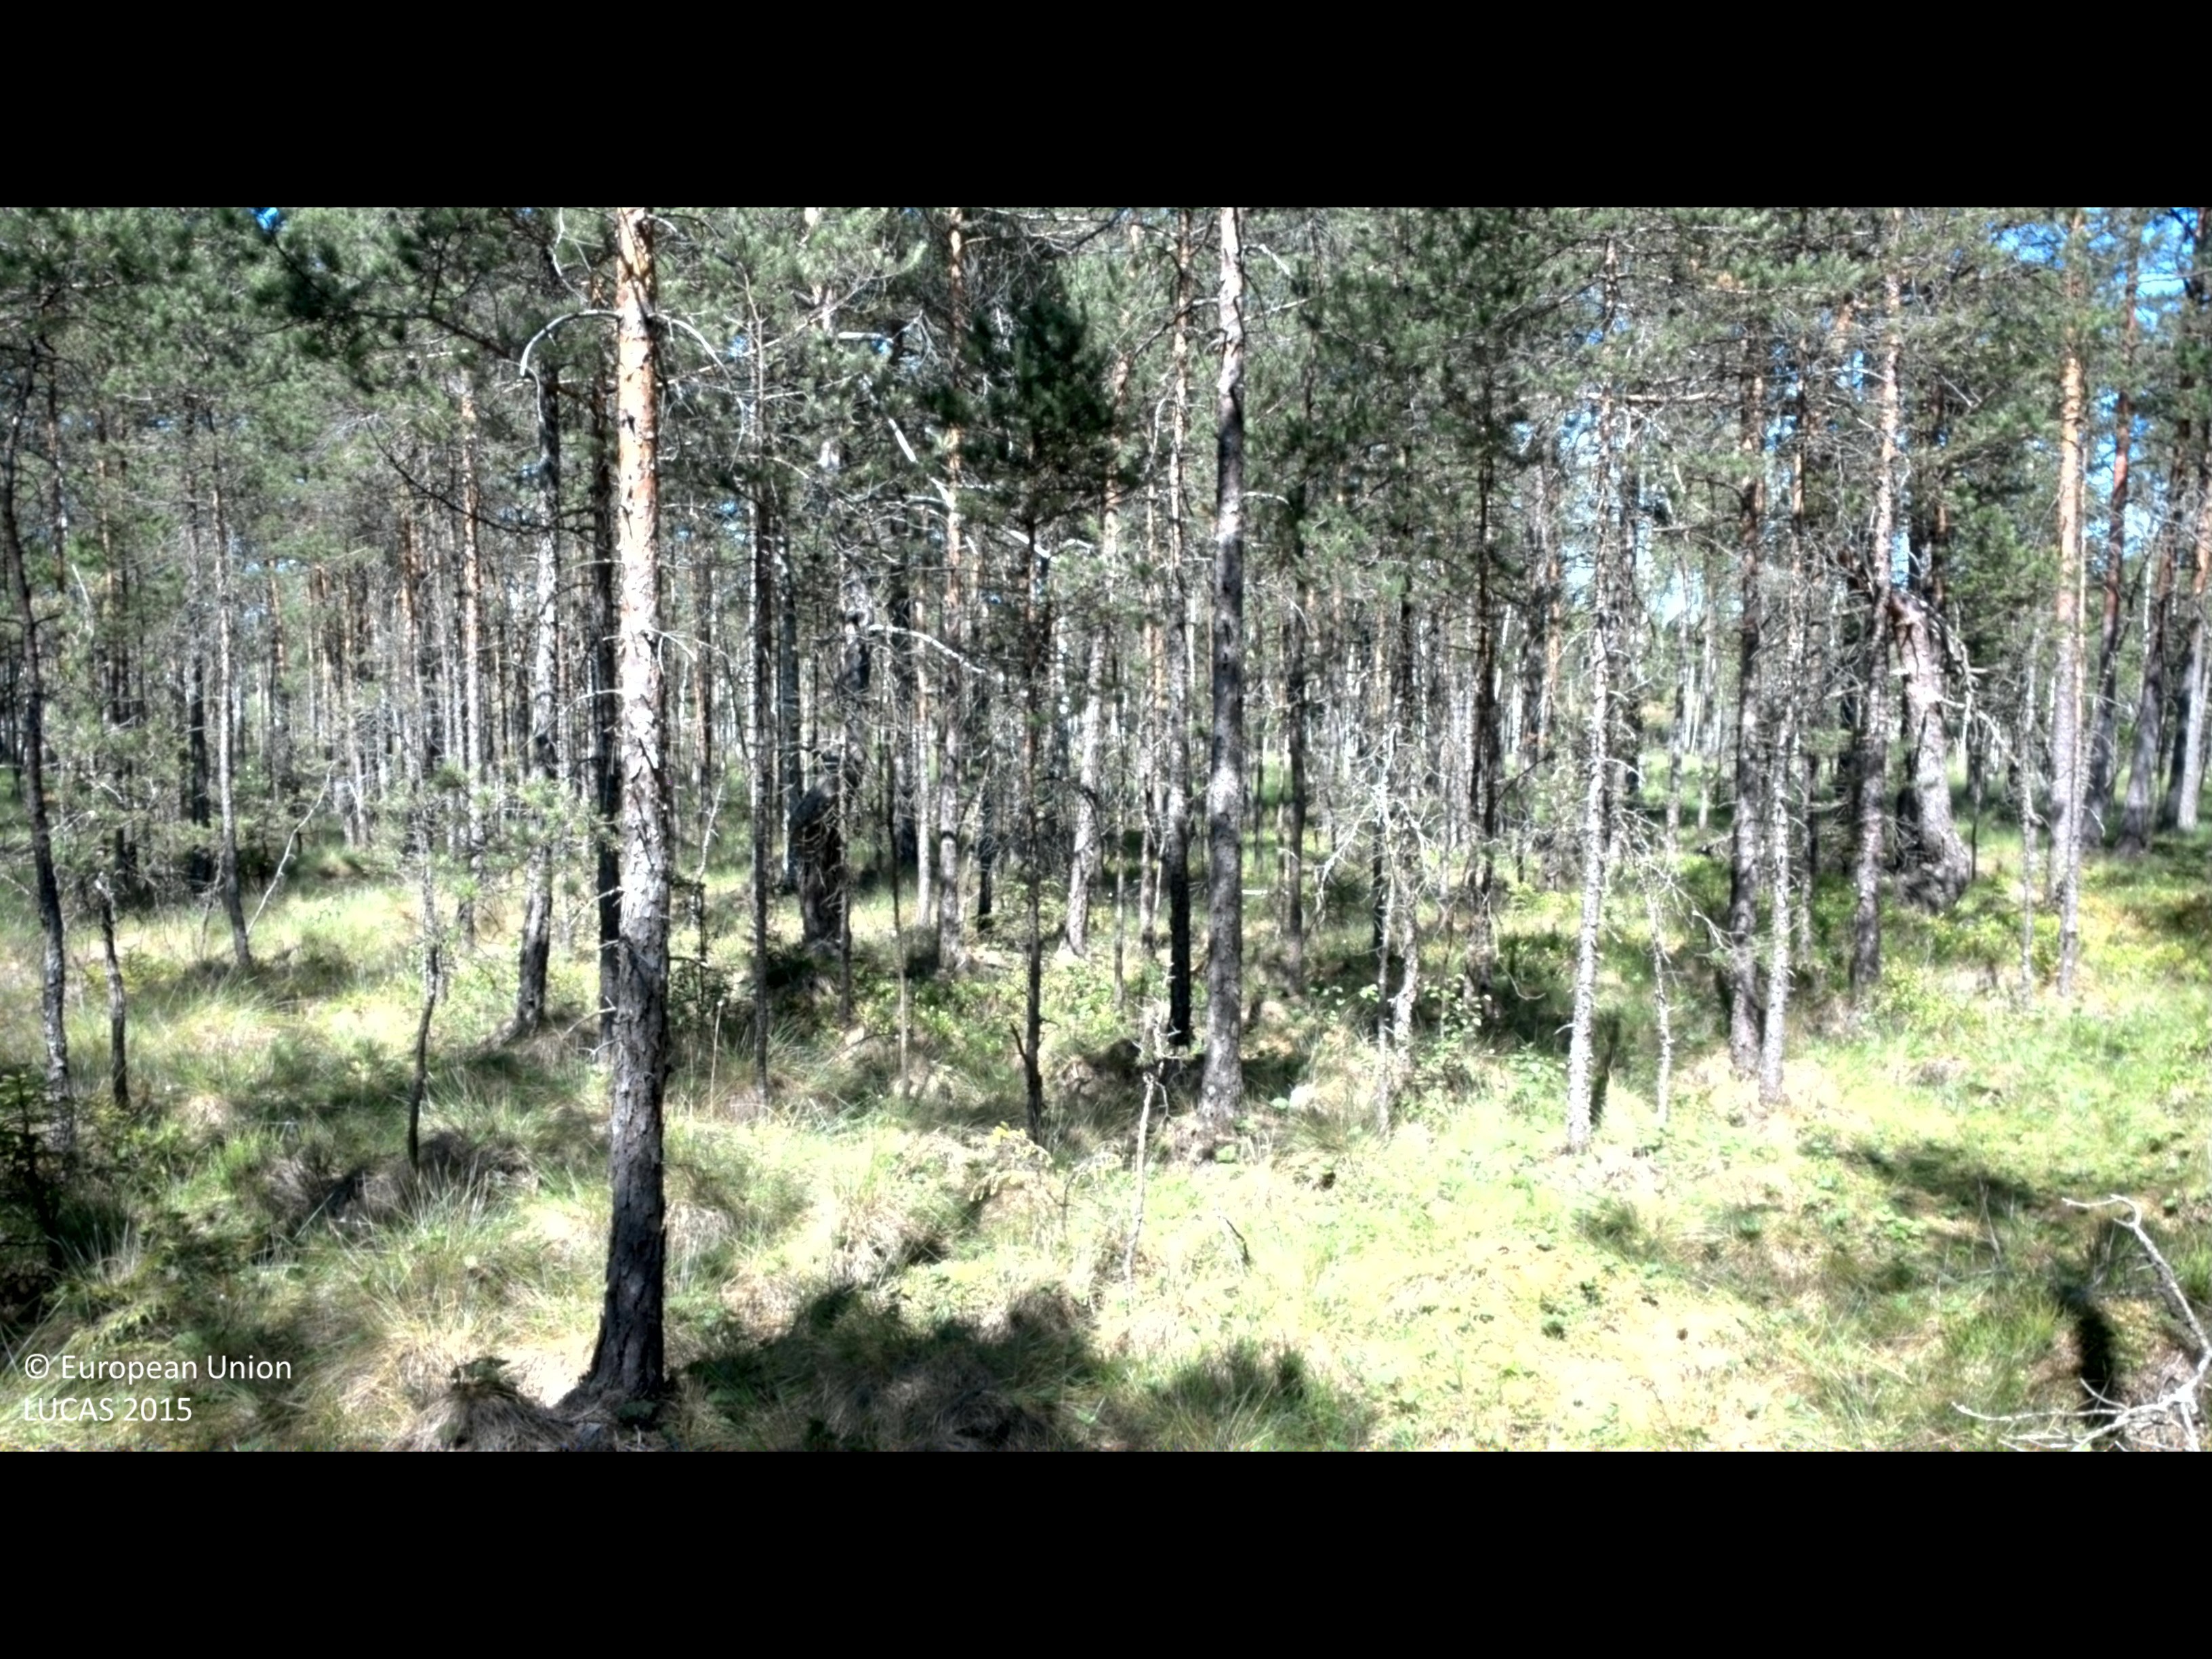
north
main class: Woodland
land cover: Pine dominated coniferous woodland
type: boreal forest
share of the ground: 50 - 75 %
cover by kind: coniferous forest trees 60 %, shrubs 20 %, herbaceous plants 10 %, lichens and mosses 10 %
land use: Forestry
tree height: > 5 m
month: July
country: SE
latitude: 56.5220
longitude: 14.5326
